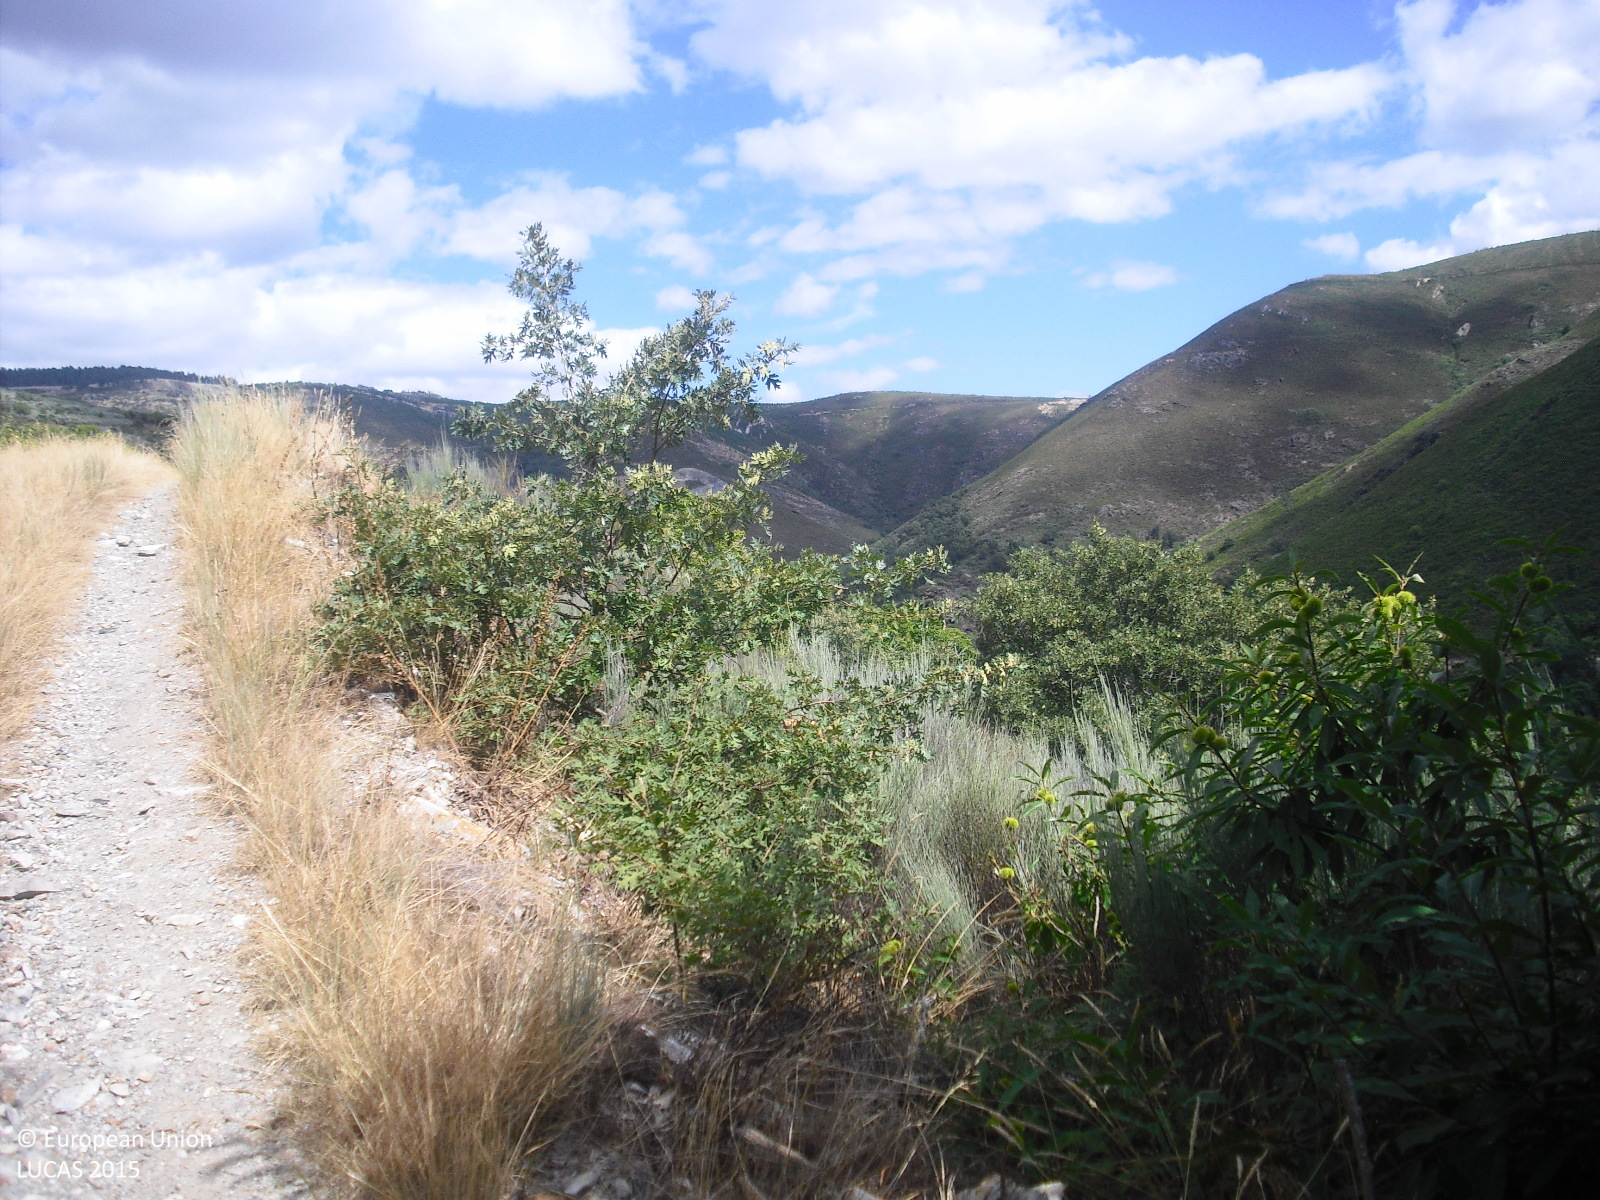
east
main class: Shrubland
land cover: Shrubland without tree cover
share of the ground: > 75 %
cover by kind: shrubs 100 %
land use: Semi-natural and natural areas not in use
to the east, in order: Shrubland without tree cover; Tracks; Broadleaved woodland; Nuts trees; Broadleaved woodland; Shrubland with sparse tree cover; Shrubland without tree cover
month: August
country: ES
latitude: 42.0734
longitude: -7.4053
